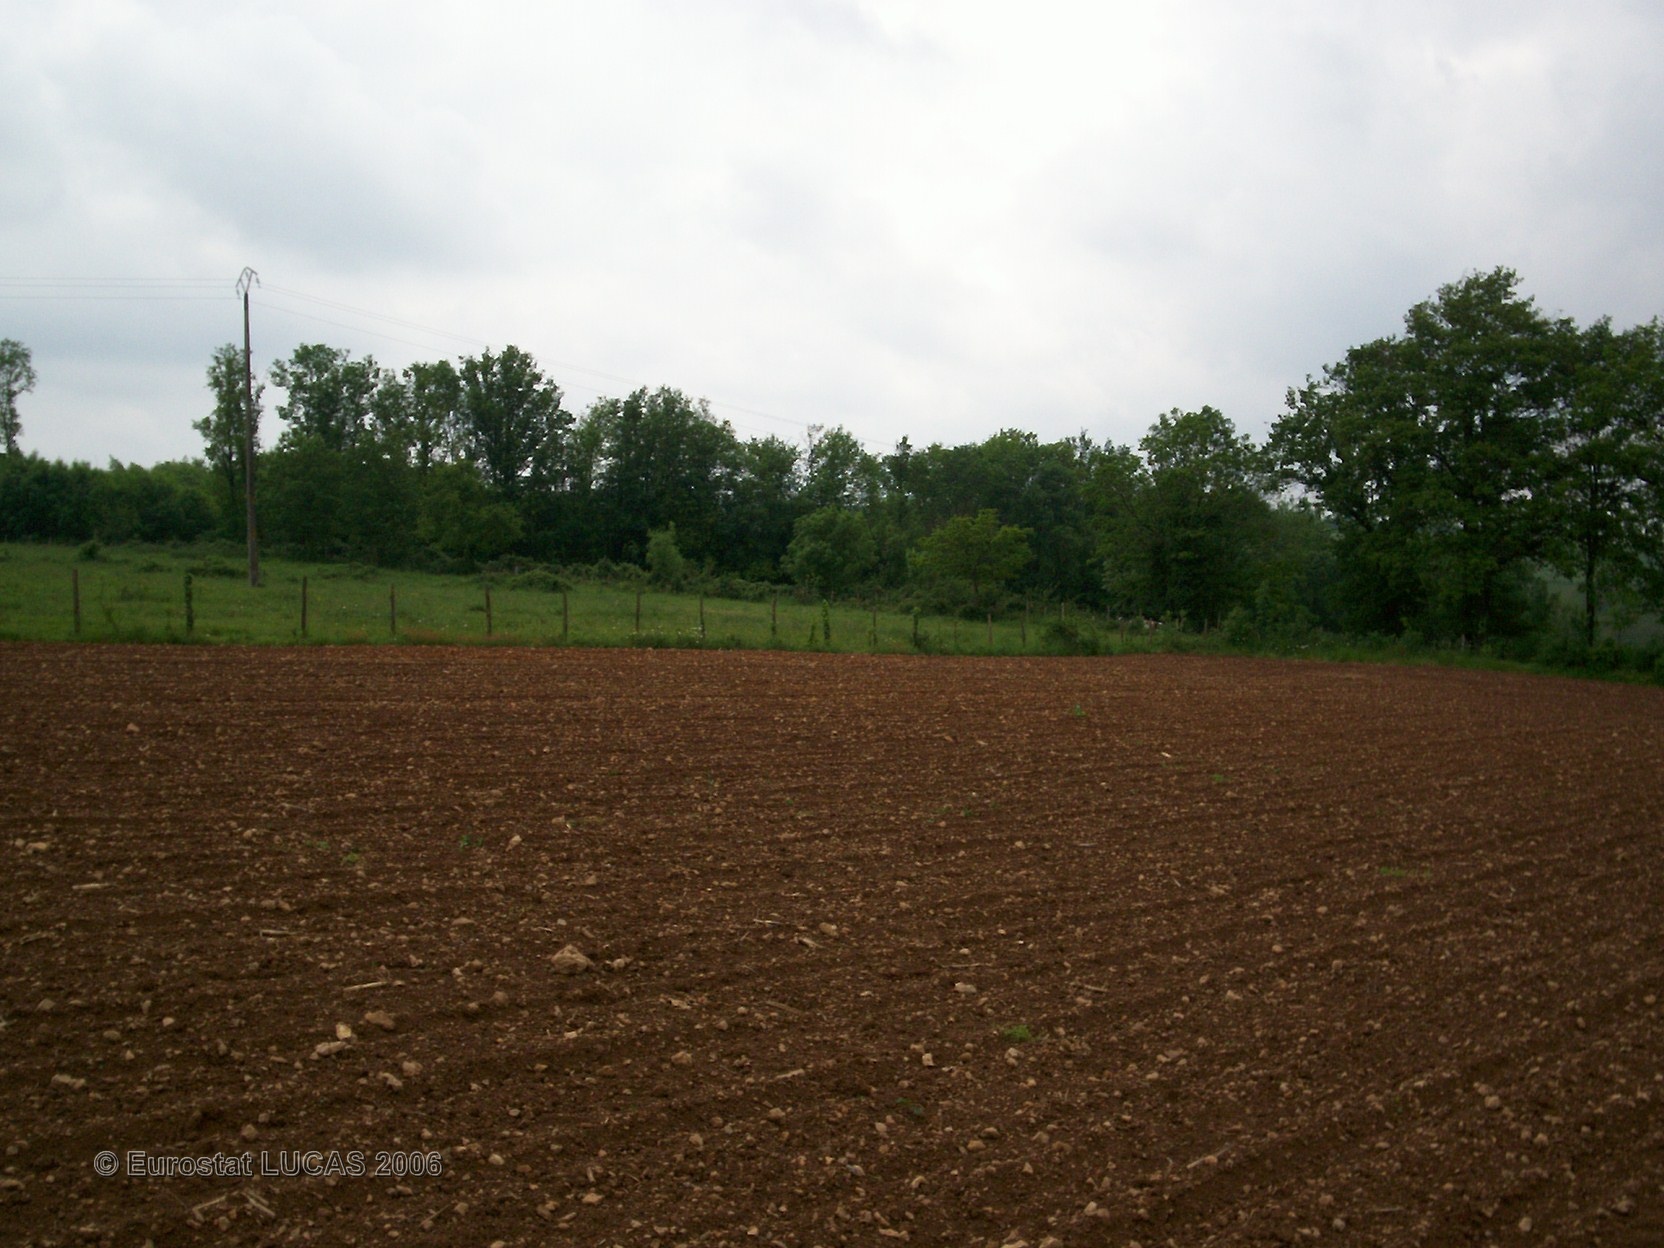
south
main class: Cropland
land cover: Maize
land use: Agriculture (excluding fallow land and kitchen gardens)
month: May
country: FR
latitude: 45.7272
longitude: 0.4902
